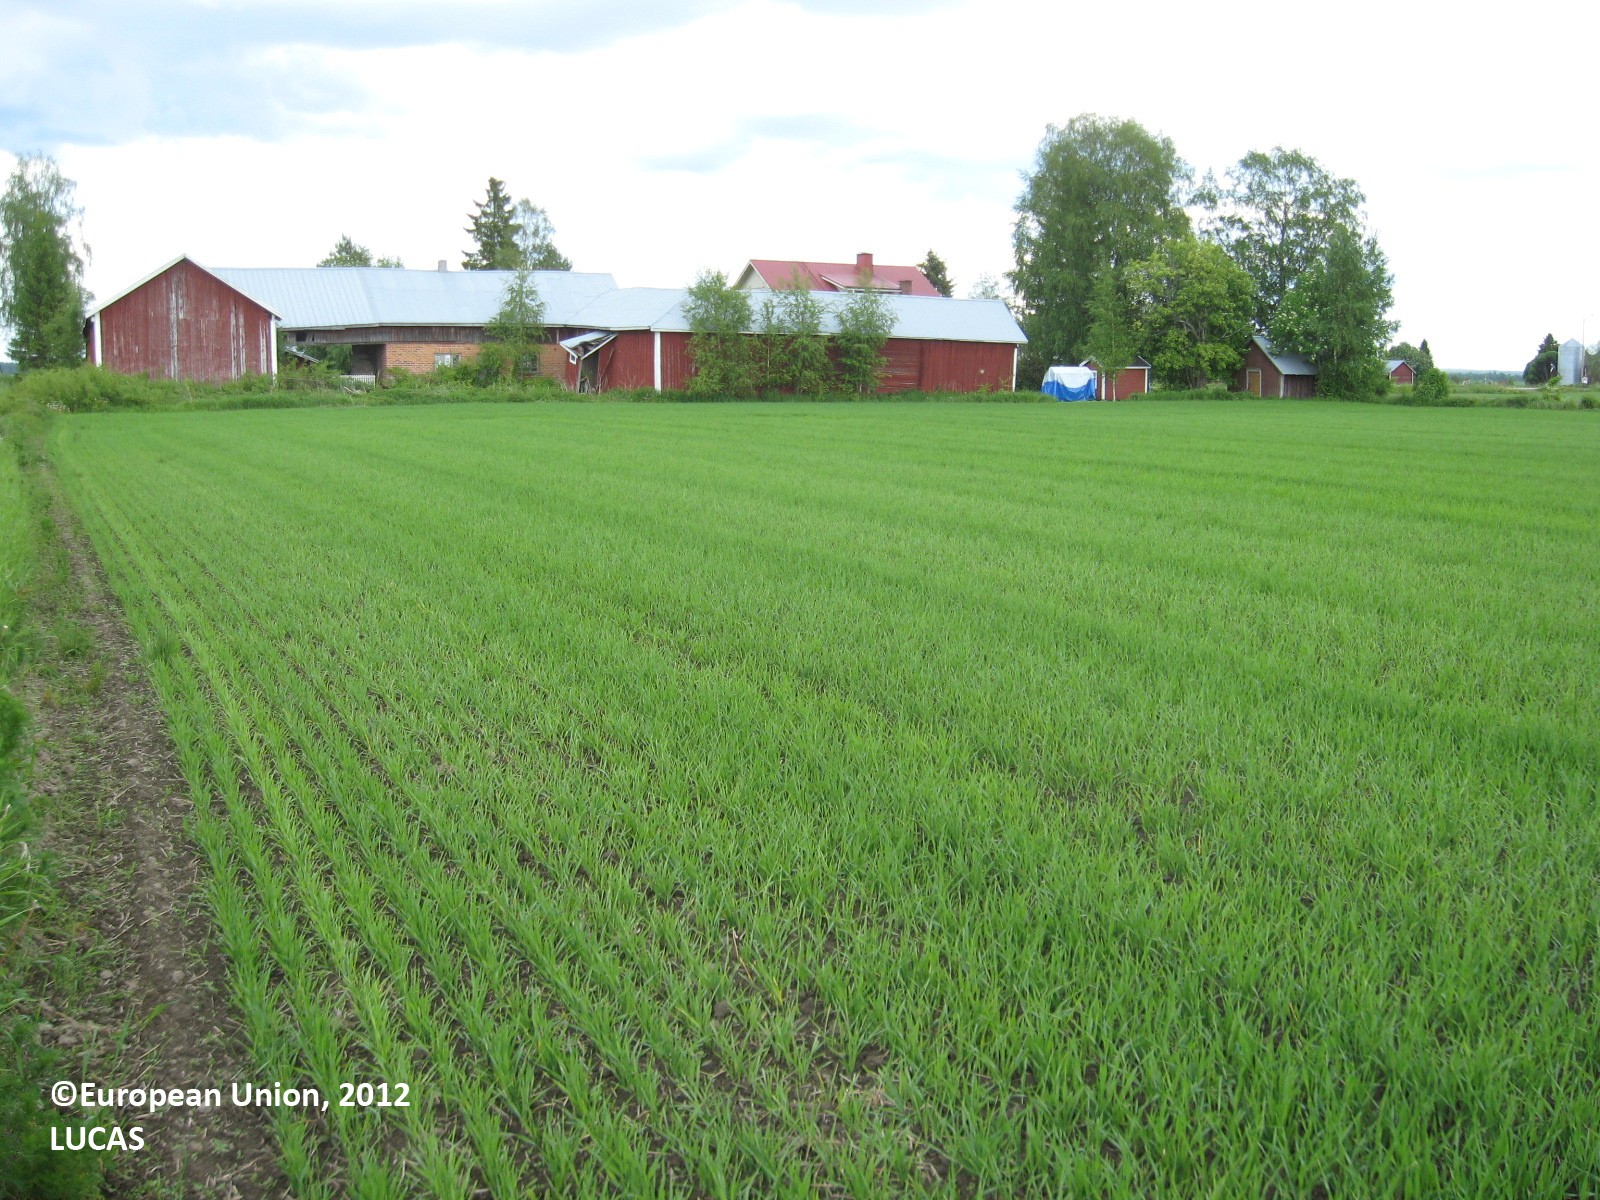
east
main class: Cropland
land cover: Barley
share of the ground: > 75 %
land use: Agriculture (excluding fallow land and kitchen gardens)
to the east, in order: Barley; Ditches and canals; Shruby margins; Artificial constructions in urban areas; Grassland without tree/shrub cover; Fences; Grassland without tree/shrub cover; Fences; Shruby margins; Ditches and canals; Grass margins; Paved roads, cycling and walking lanes; Grass margins; Ditches and canals; Shruby margins; Ditches and canals; Shruby margins; Barley
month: June
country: FI
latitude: 63.0658
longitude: 22.8590
